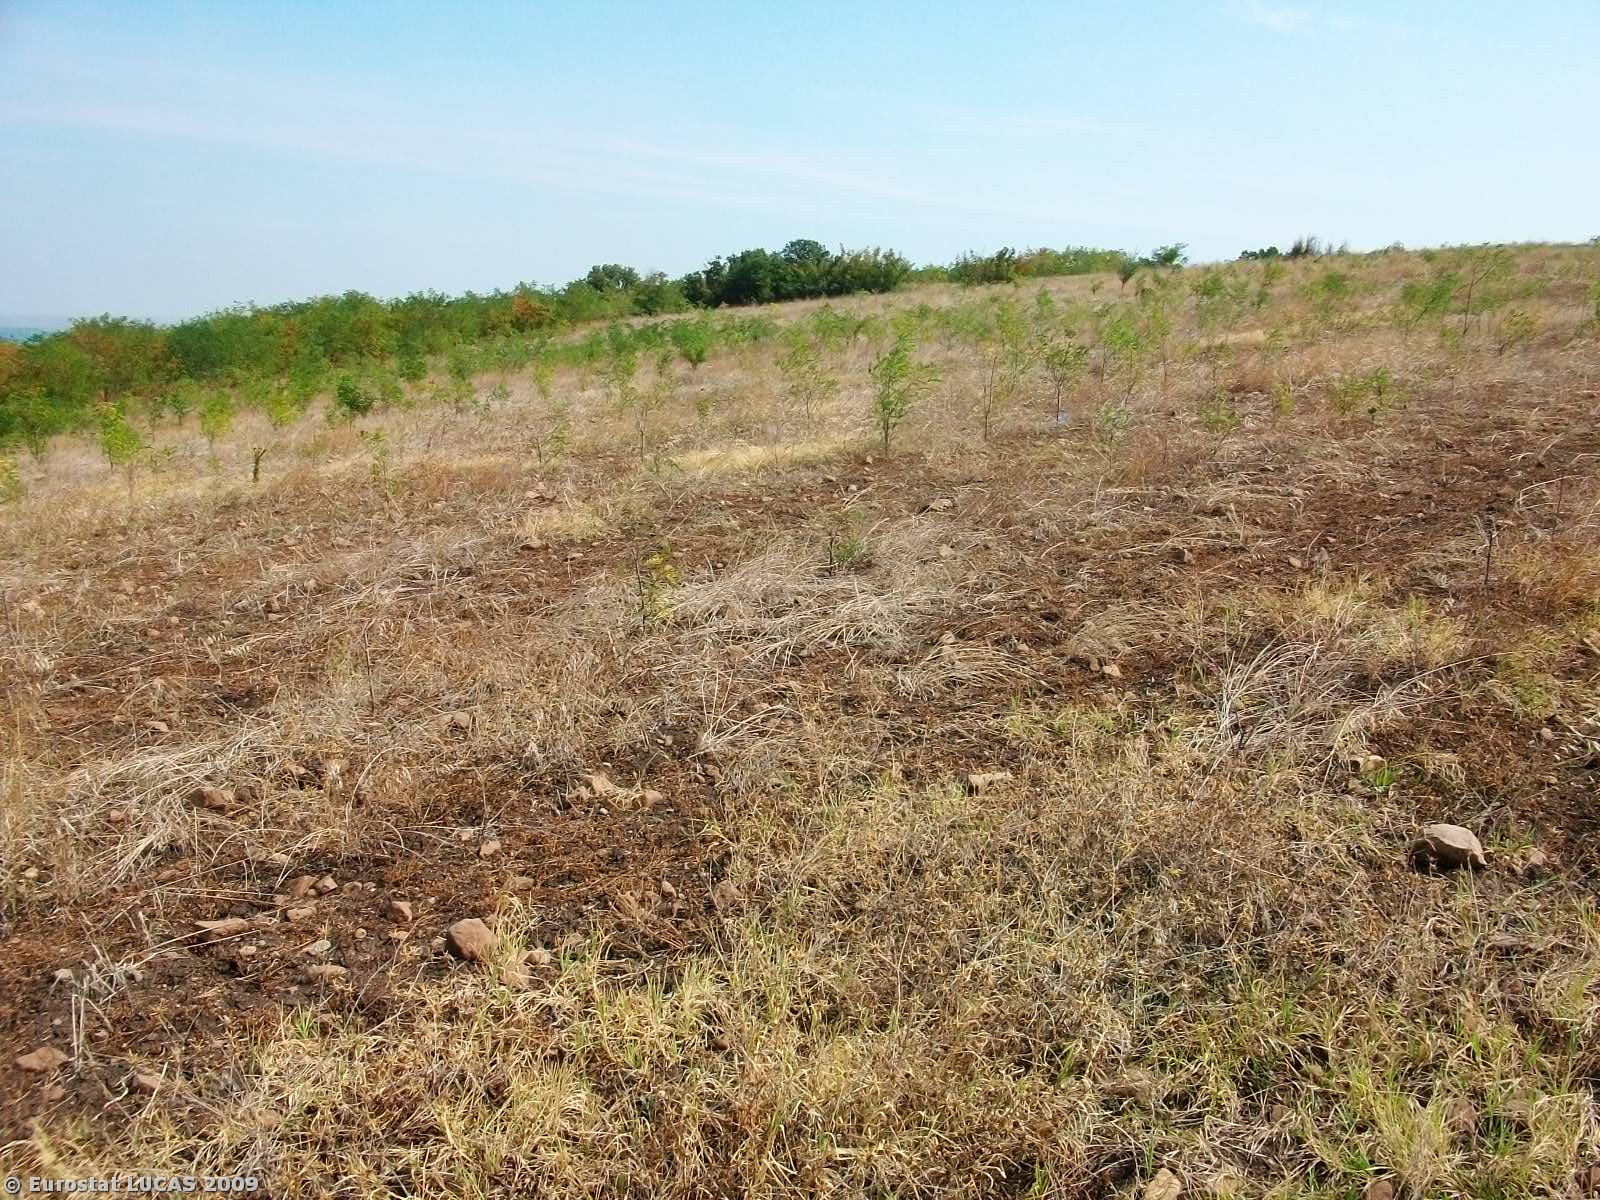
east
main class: Grassland
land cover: Grassland with sparse tree/shrub cover
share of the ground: 50 - 75 %
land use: Forestry
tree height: > 5 m
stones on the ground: 10 - 25 %
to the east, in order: Grassland with sparse tree/shrub cover; Shruby margins; Tracks; Broadleaved woodland; Spontaneously vegetated surfaces; Broadleaved woodland
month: September
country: GR
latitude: 40.9718
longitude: 26.3116
